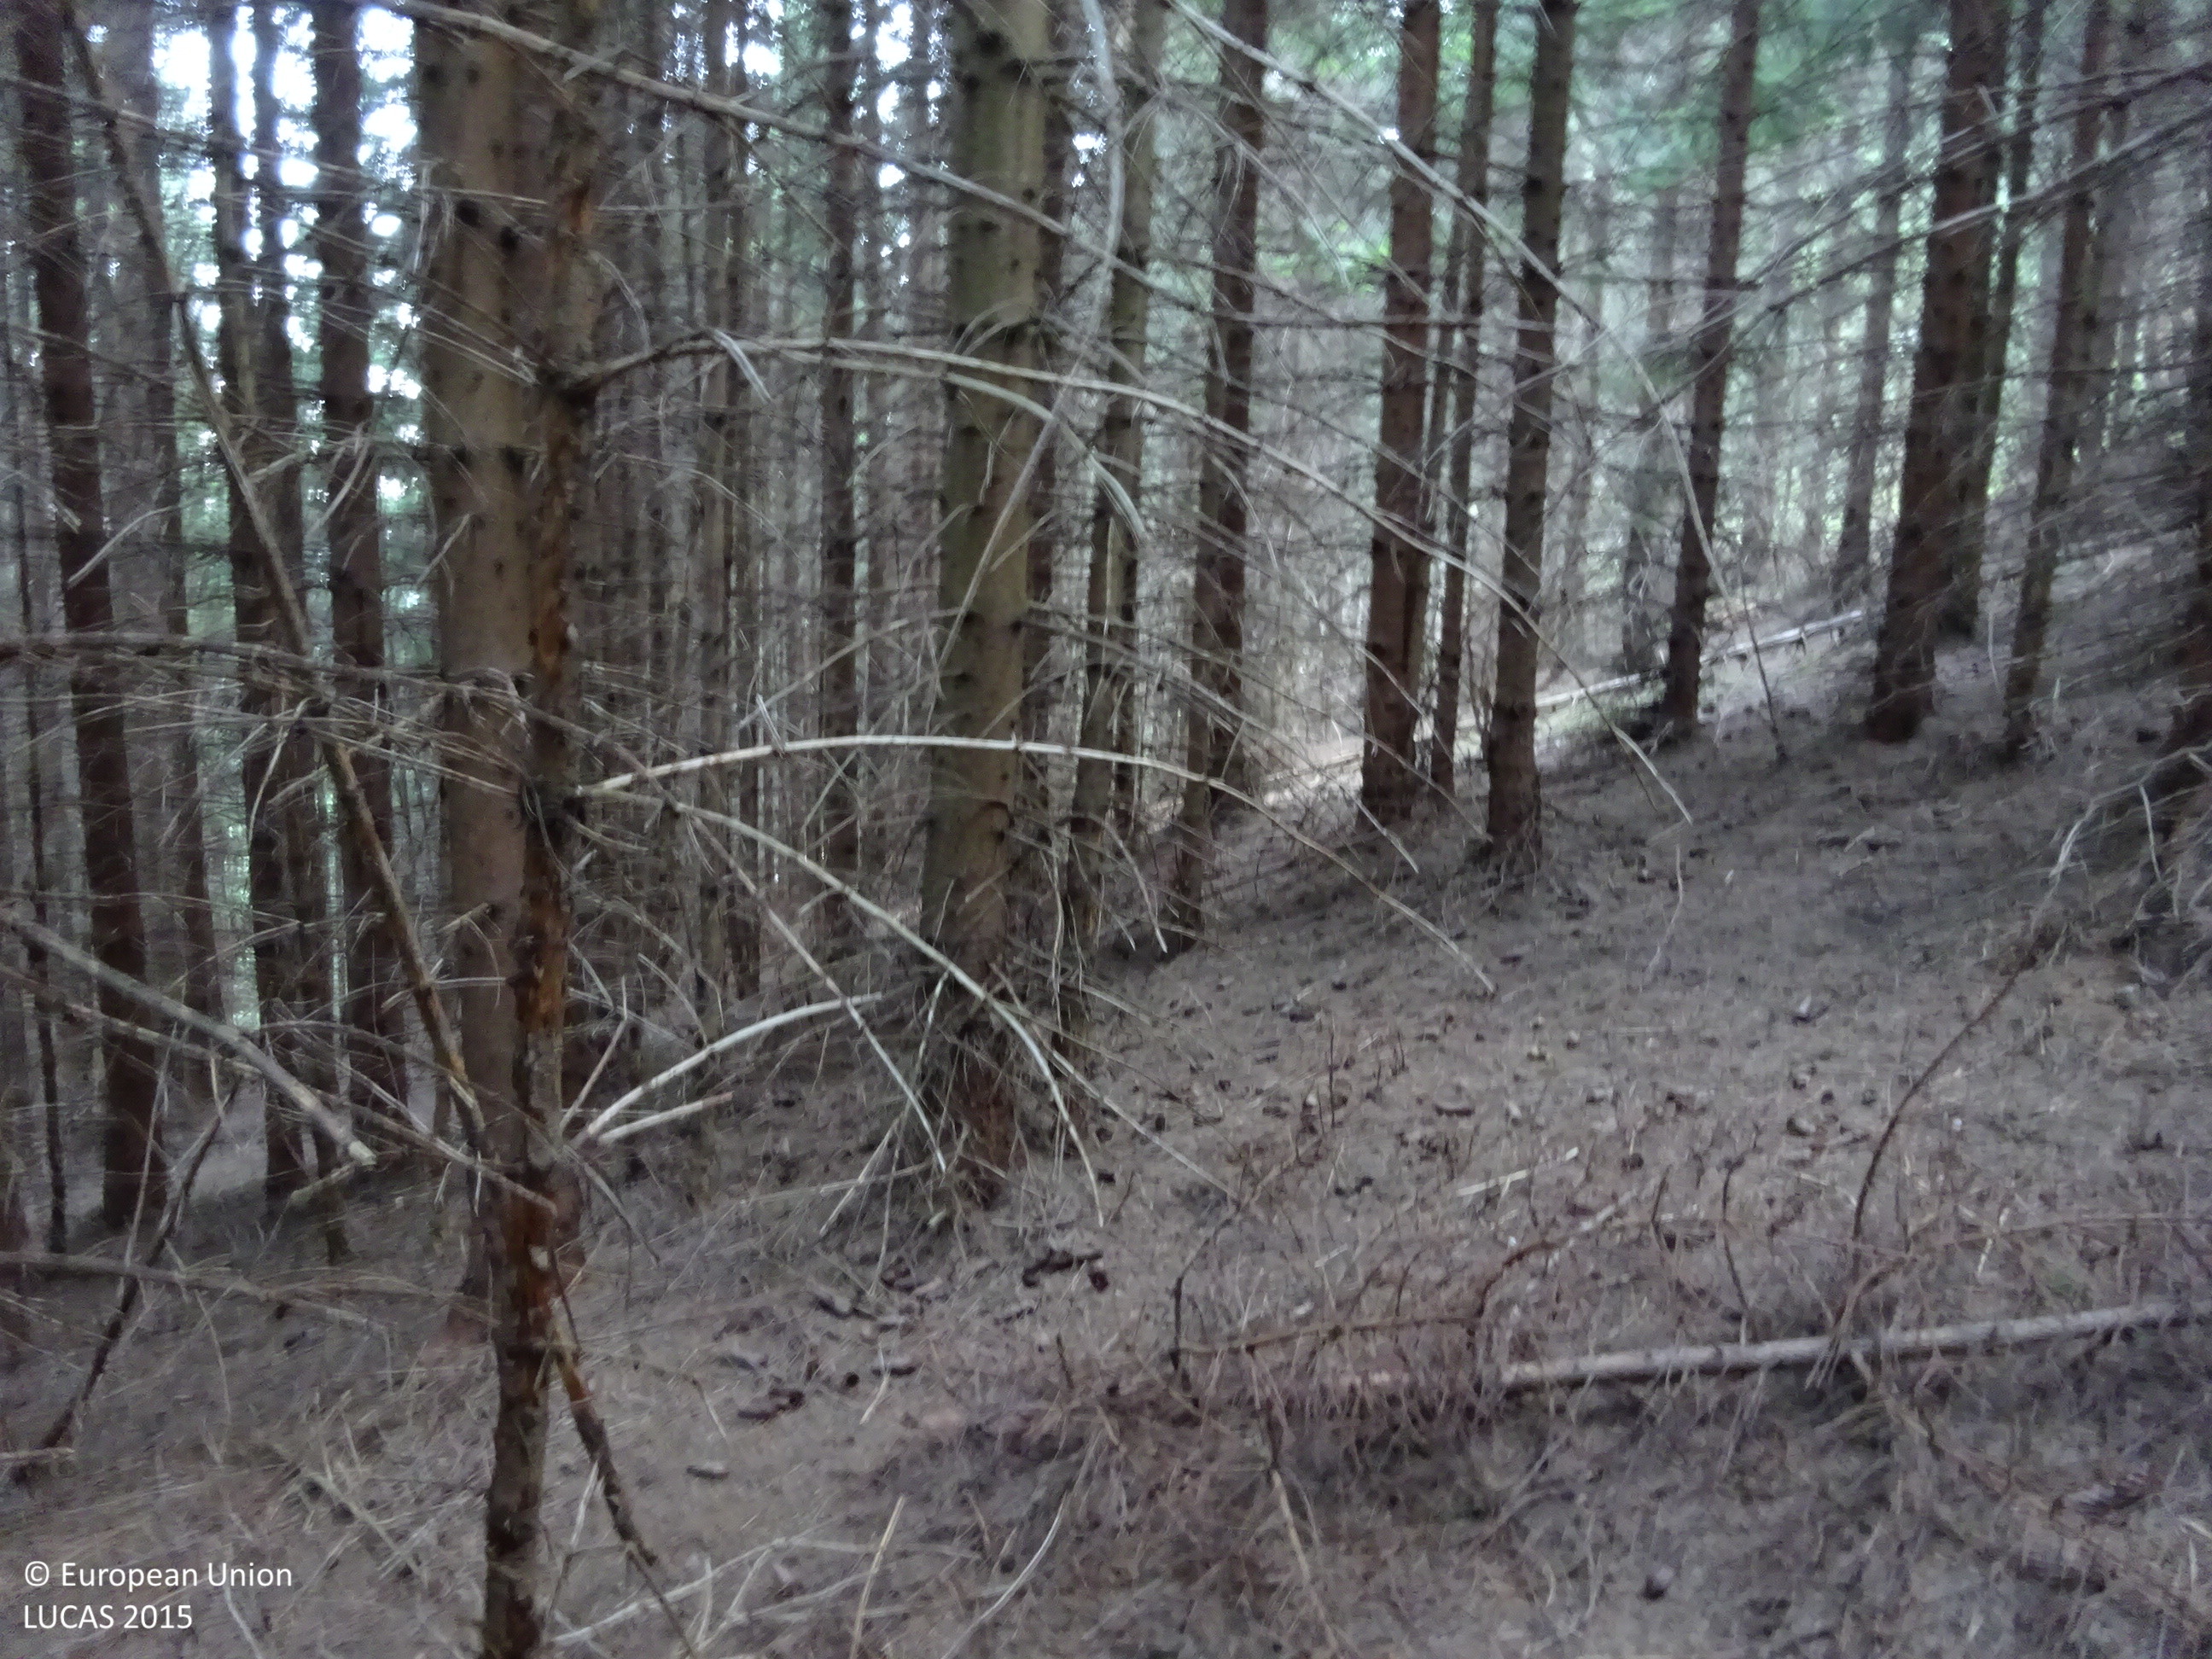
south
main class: Woodland
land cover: Spruce dominated coniferous woodland
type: alpine coniferous forest
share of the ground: > 75 %
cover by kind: coniferous forest trees 100 %
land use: Forestry
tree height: > 5 m
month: August
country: AT
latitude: 47.5551
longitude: 15.9957
